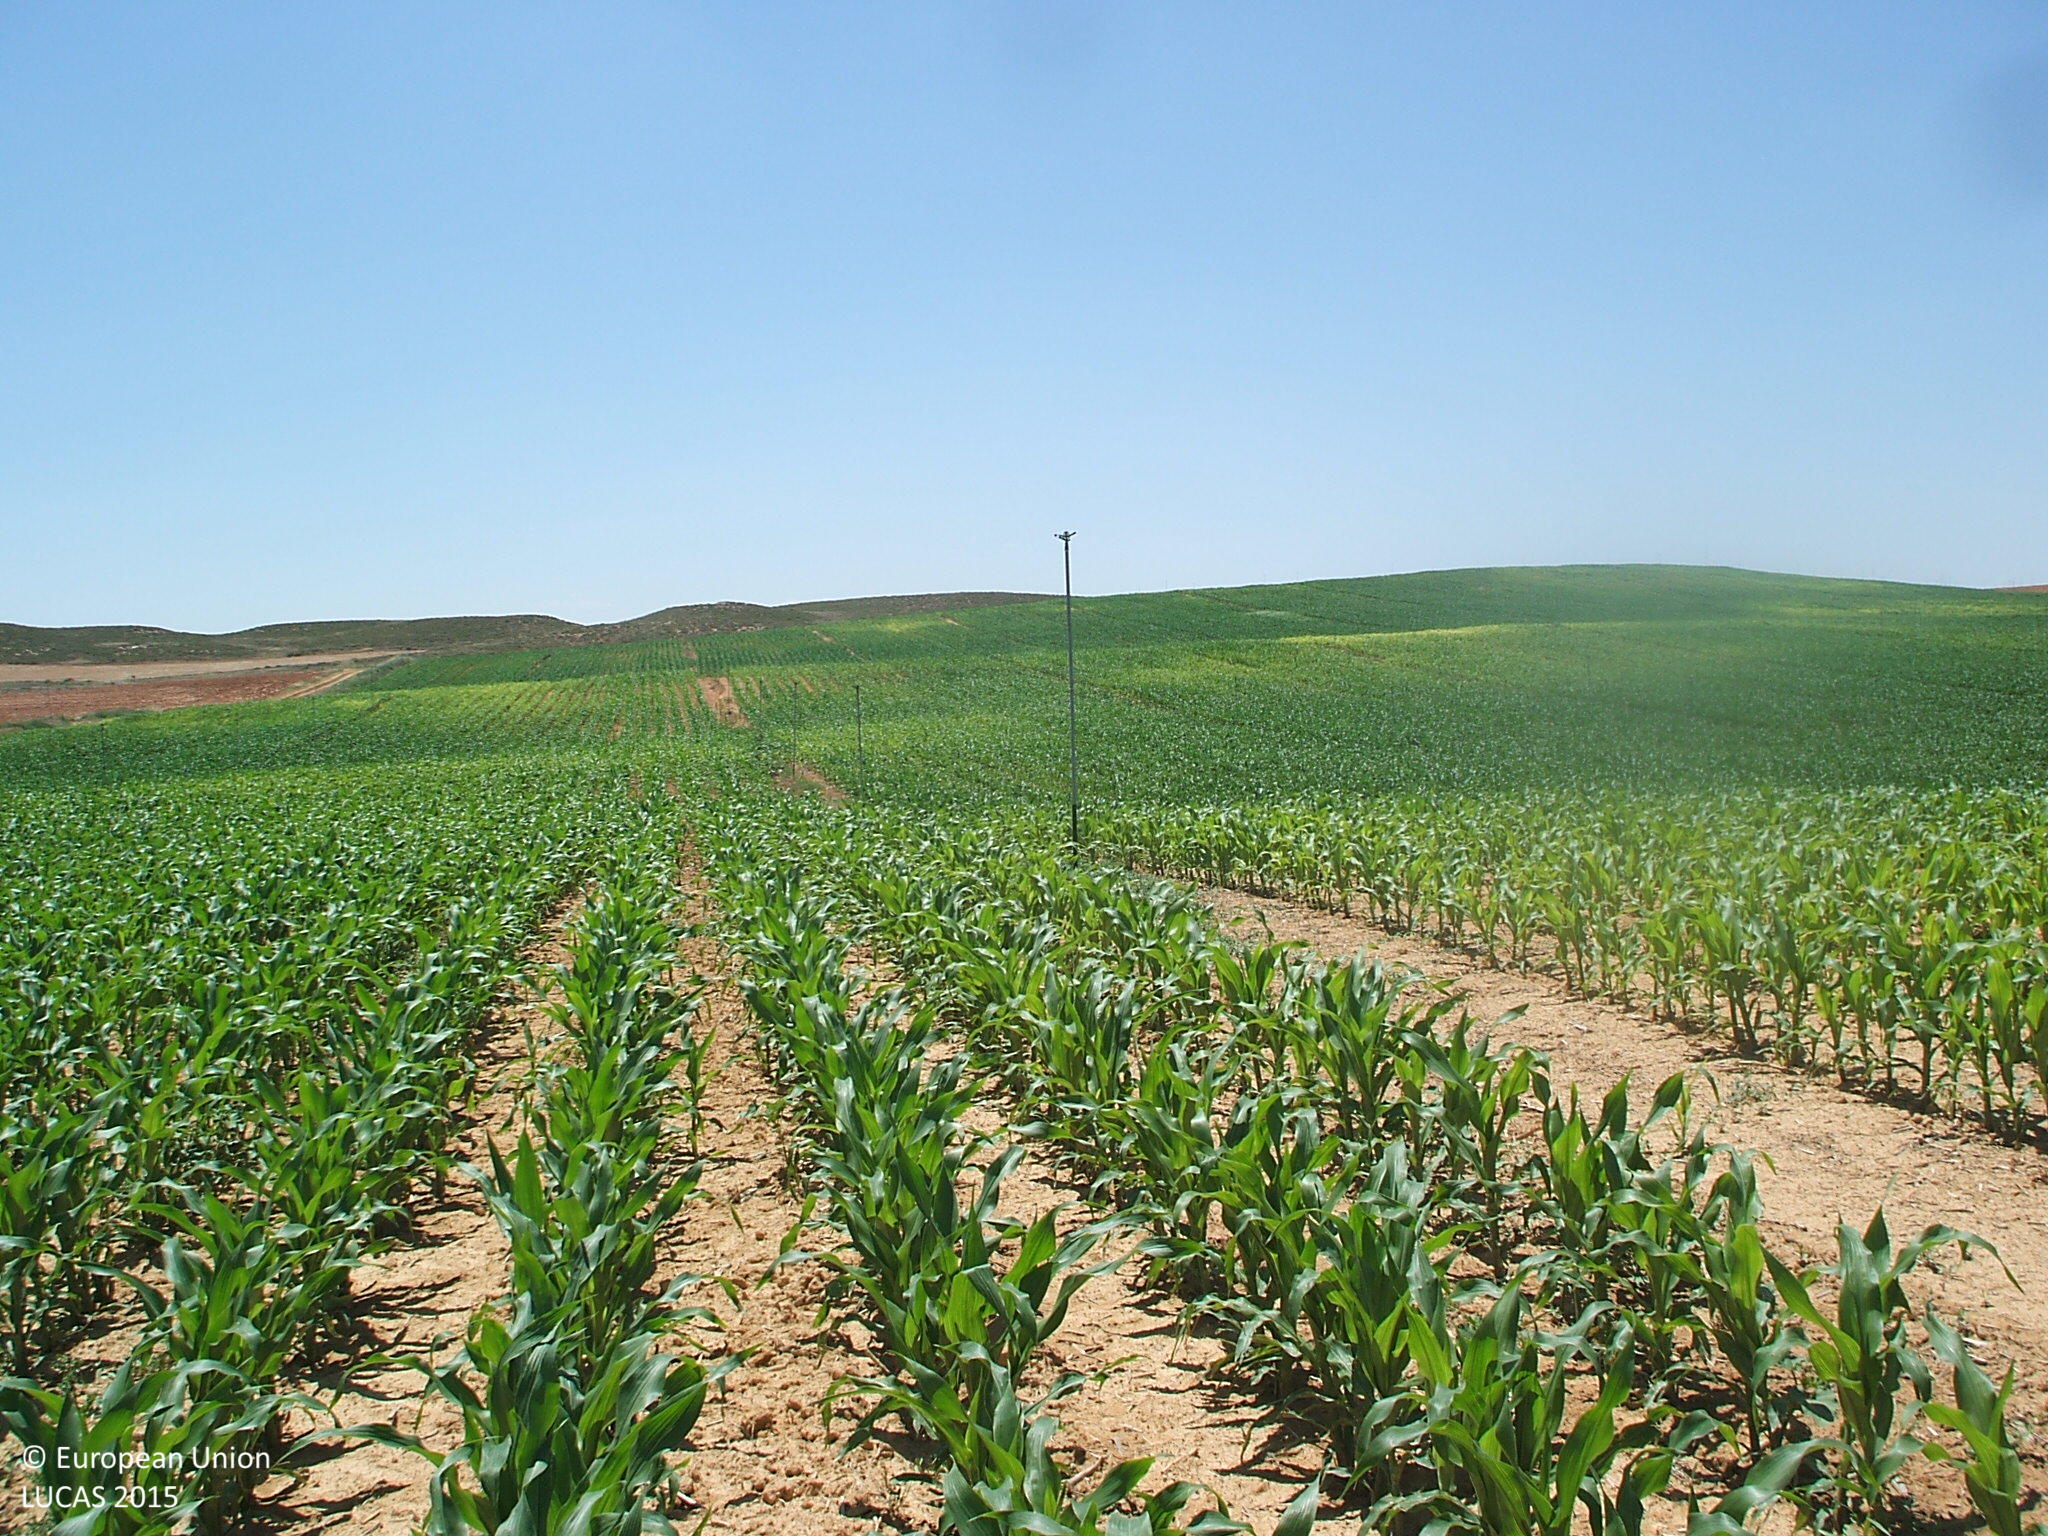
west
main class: Cropland
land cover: Maize
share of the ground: 50 - 75 %
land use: Agriculture (excluding fallow land and kitchen gardens)
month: June
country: ES
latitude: 41.0631
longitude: -0.2101
